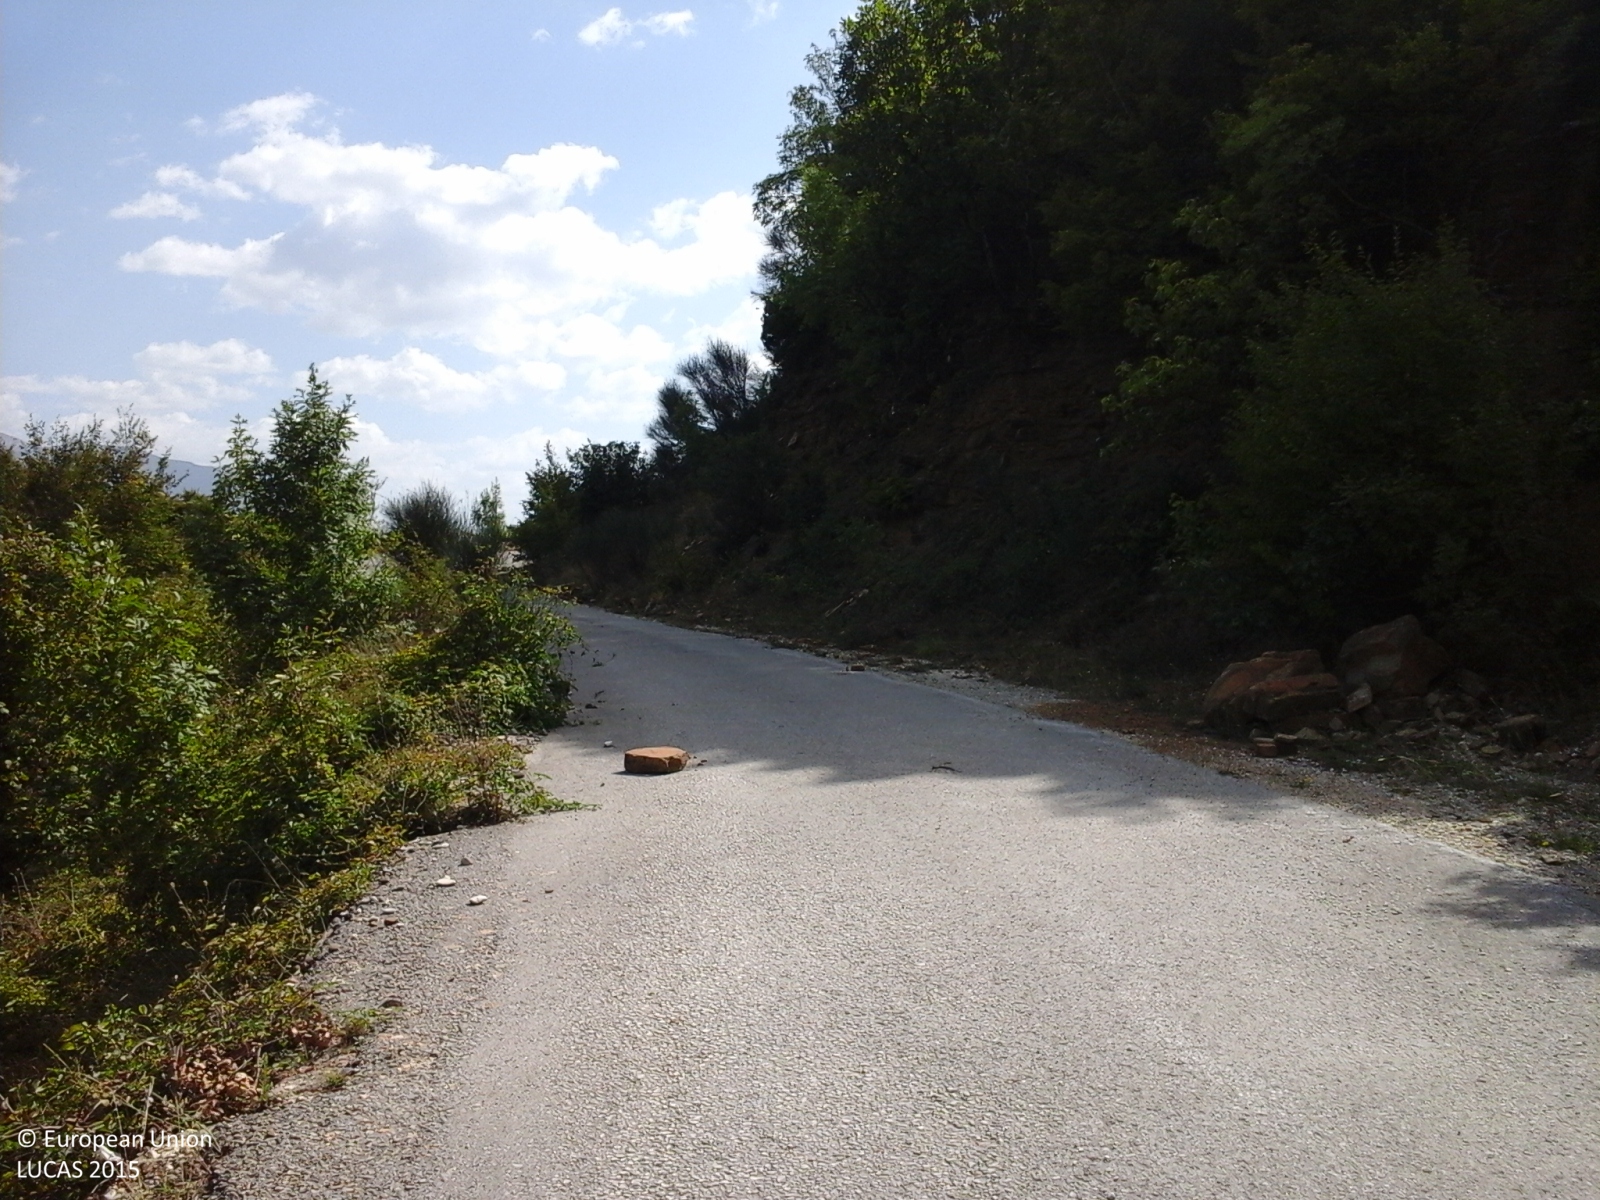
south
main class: Woodland
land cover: Broadleaved woodland
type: thermophilous deciduous forest
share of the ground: > 75 %
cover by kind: broadleaved forest trees 90 %, shrubs 5 %, herbaceous plants 5 %
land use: Forestry
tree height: > 5 m
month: September
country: GR
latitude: 39.6862
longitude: 20.9749
